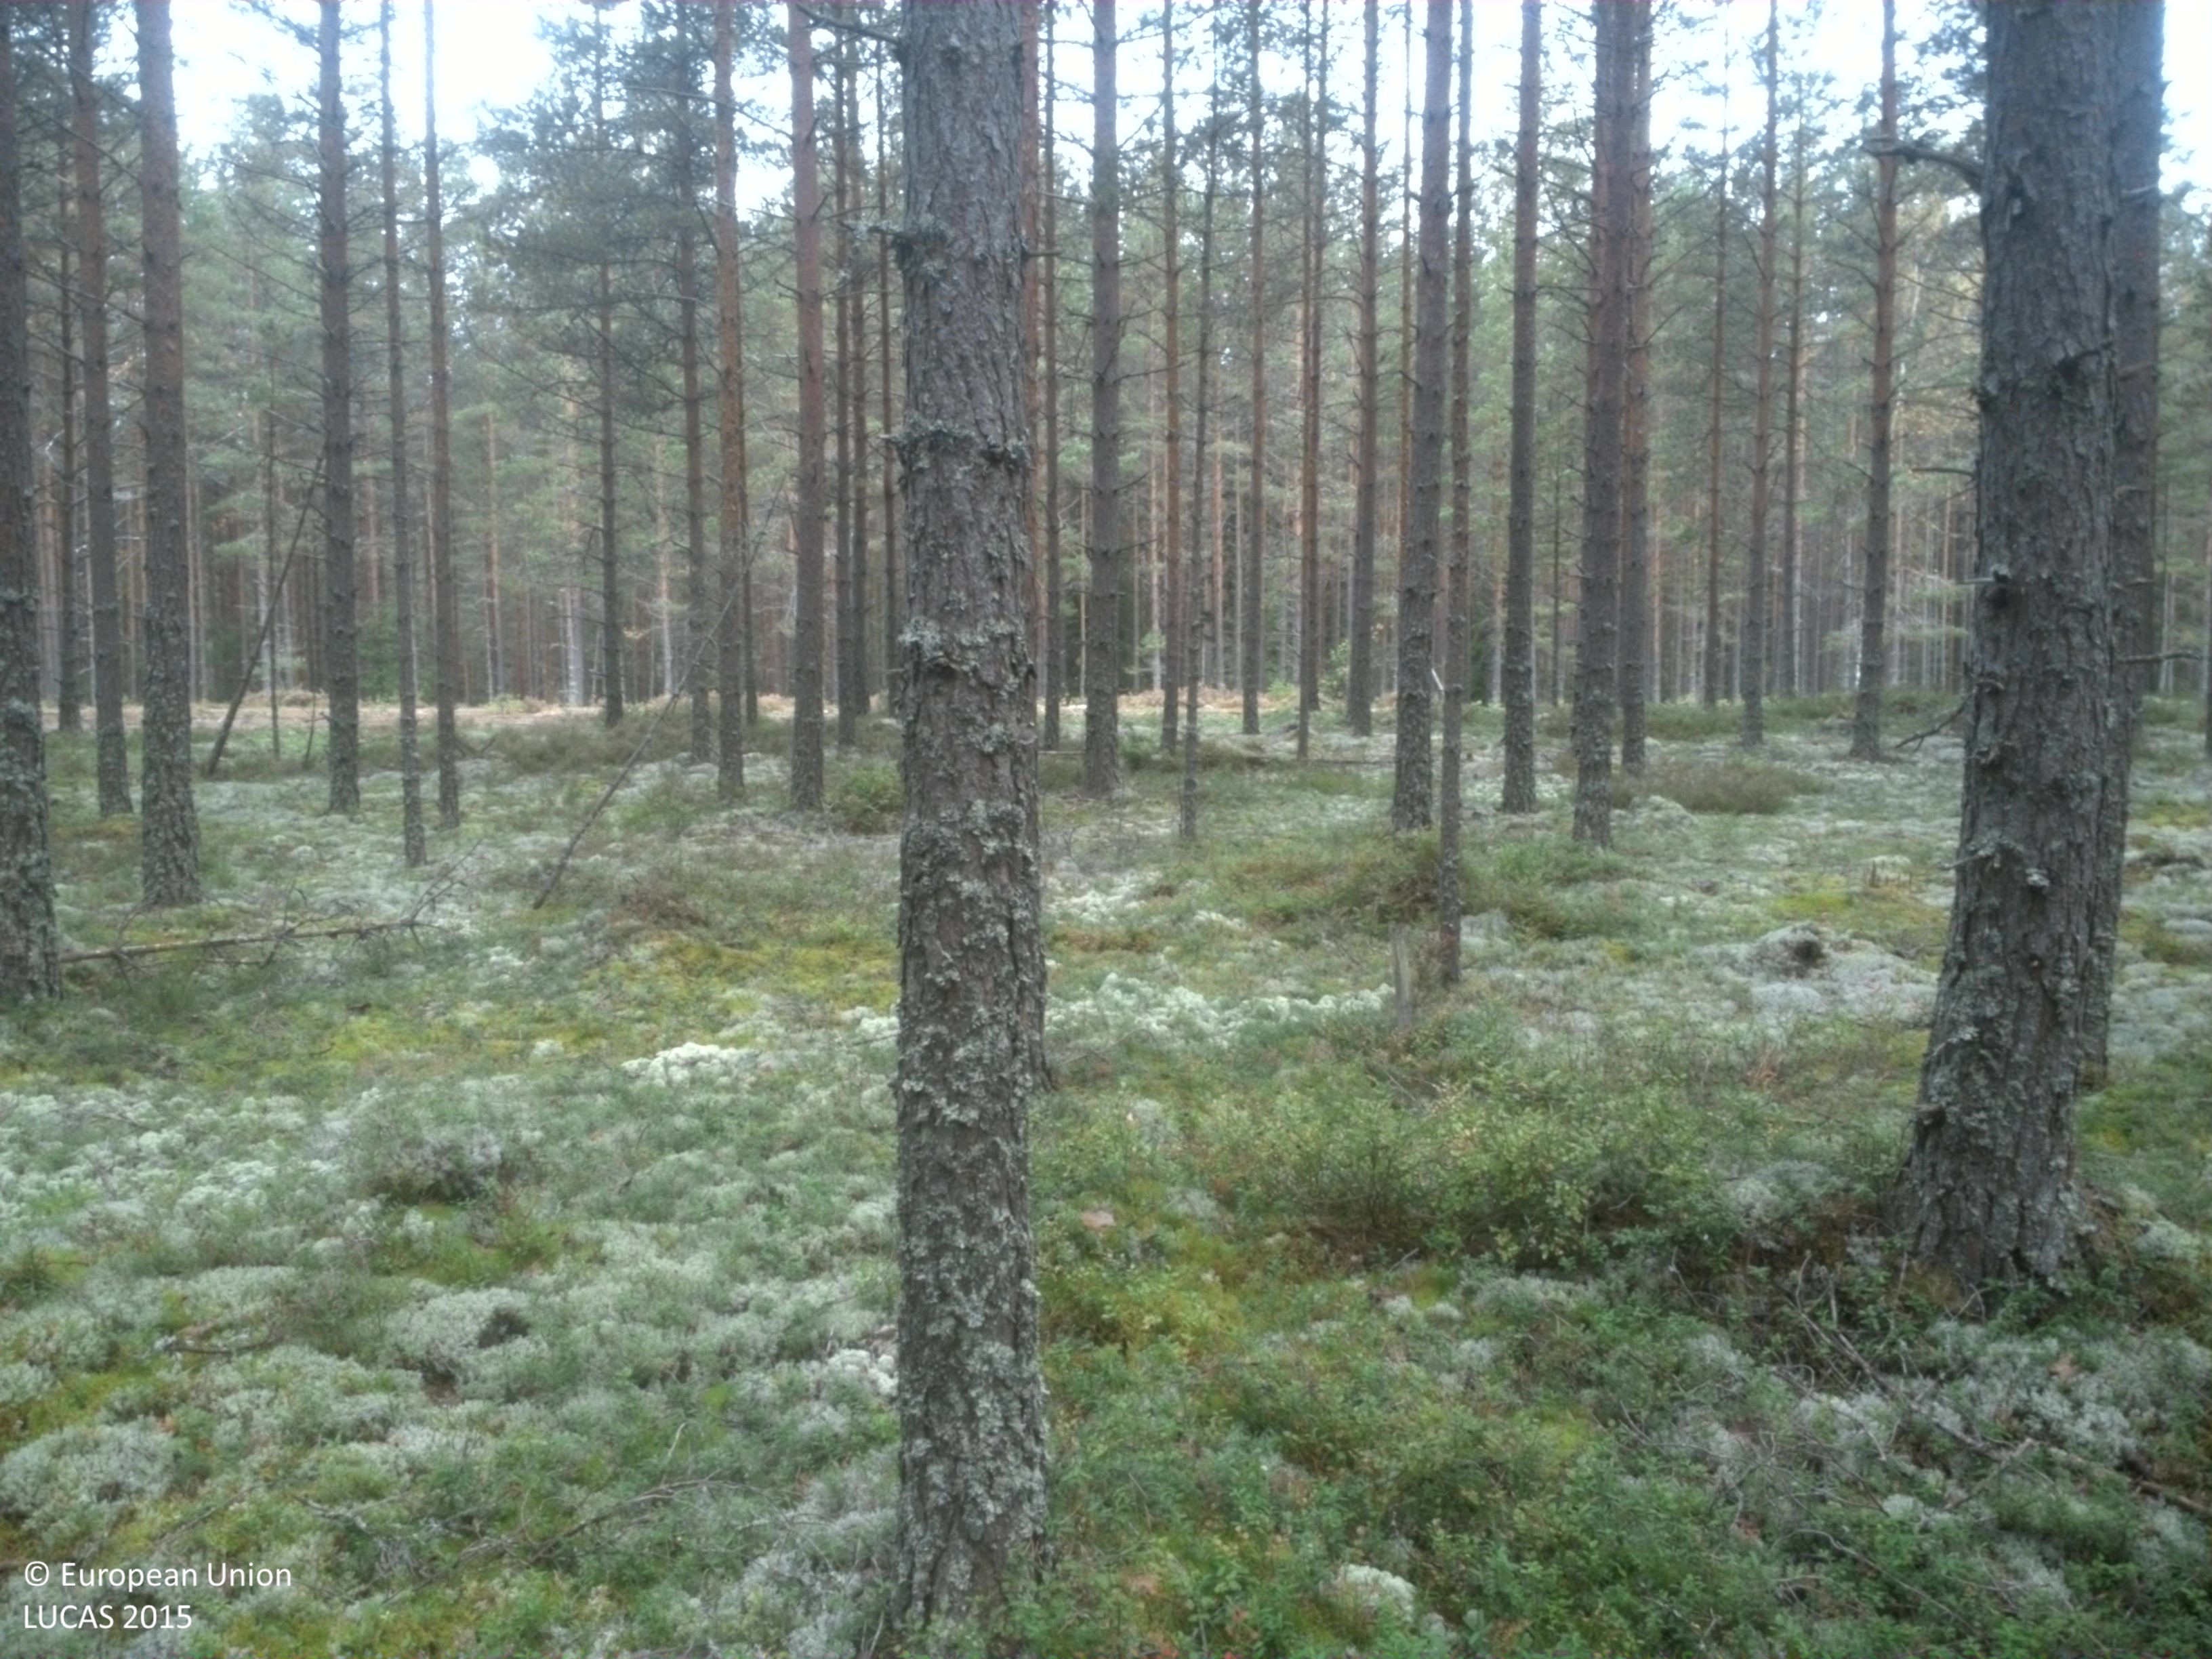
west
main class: Woodland
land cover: Pine dominated coniferous woodland
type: boreal forest
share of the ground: 50 - 75 %
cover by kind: coniferous forest trees 70 %, lichens and mosses 20 %, shrubs 10 %
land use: Forestry
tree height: > 5 m
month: September
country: SE
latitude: 59.8028
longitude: 15.4978
